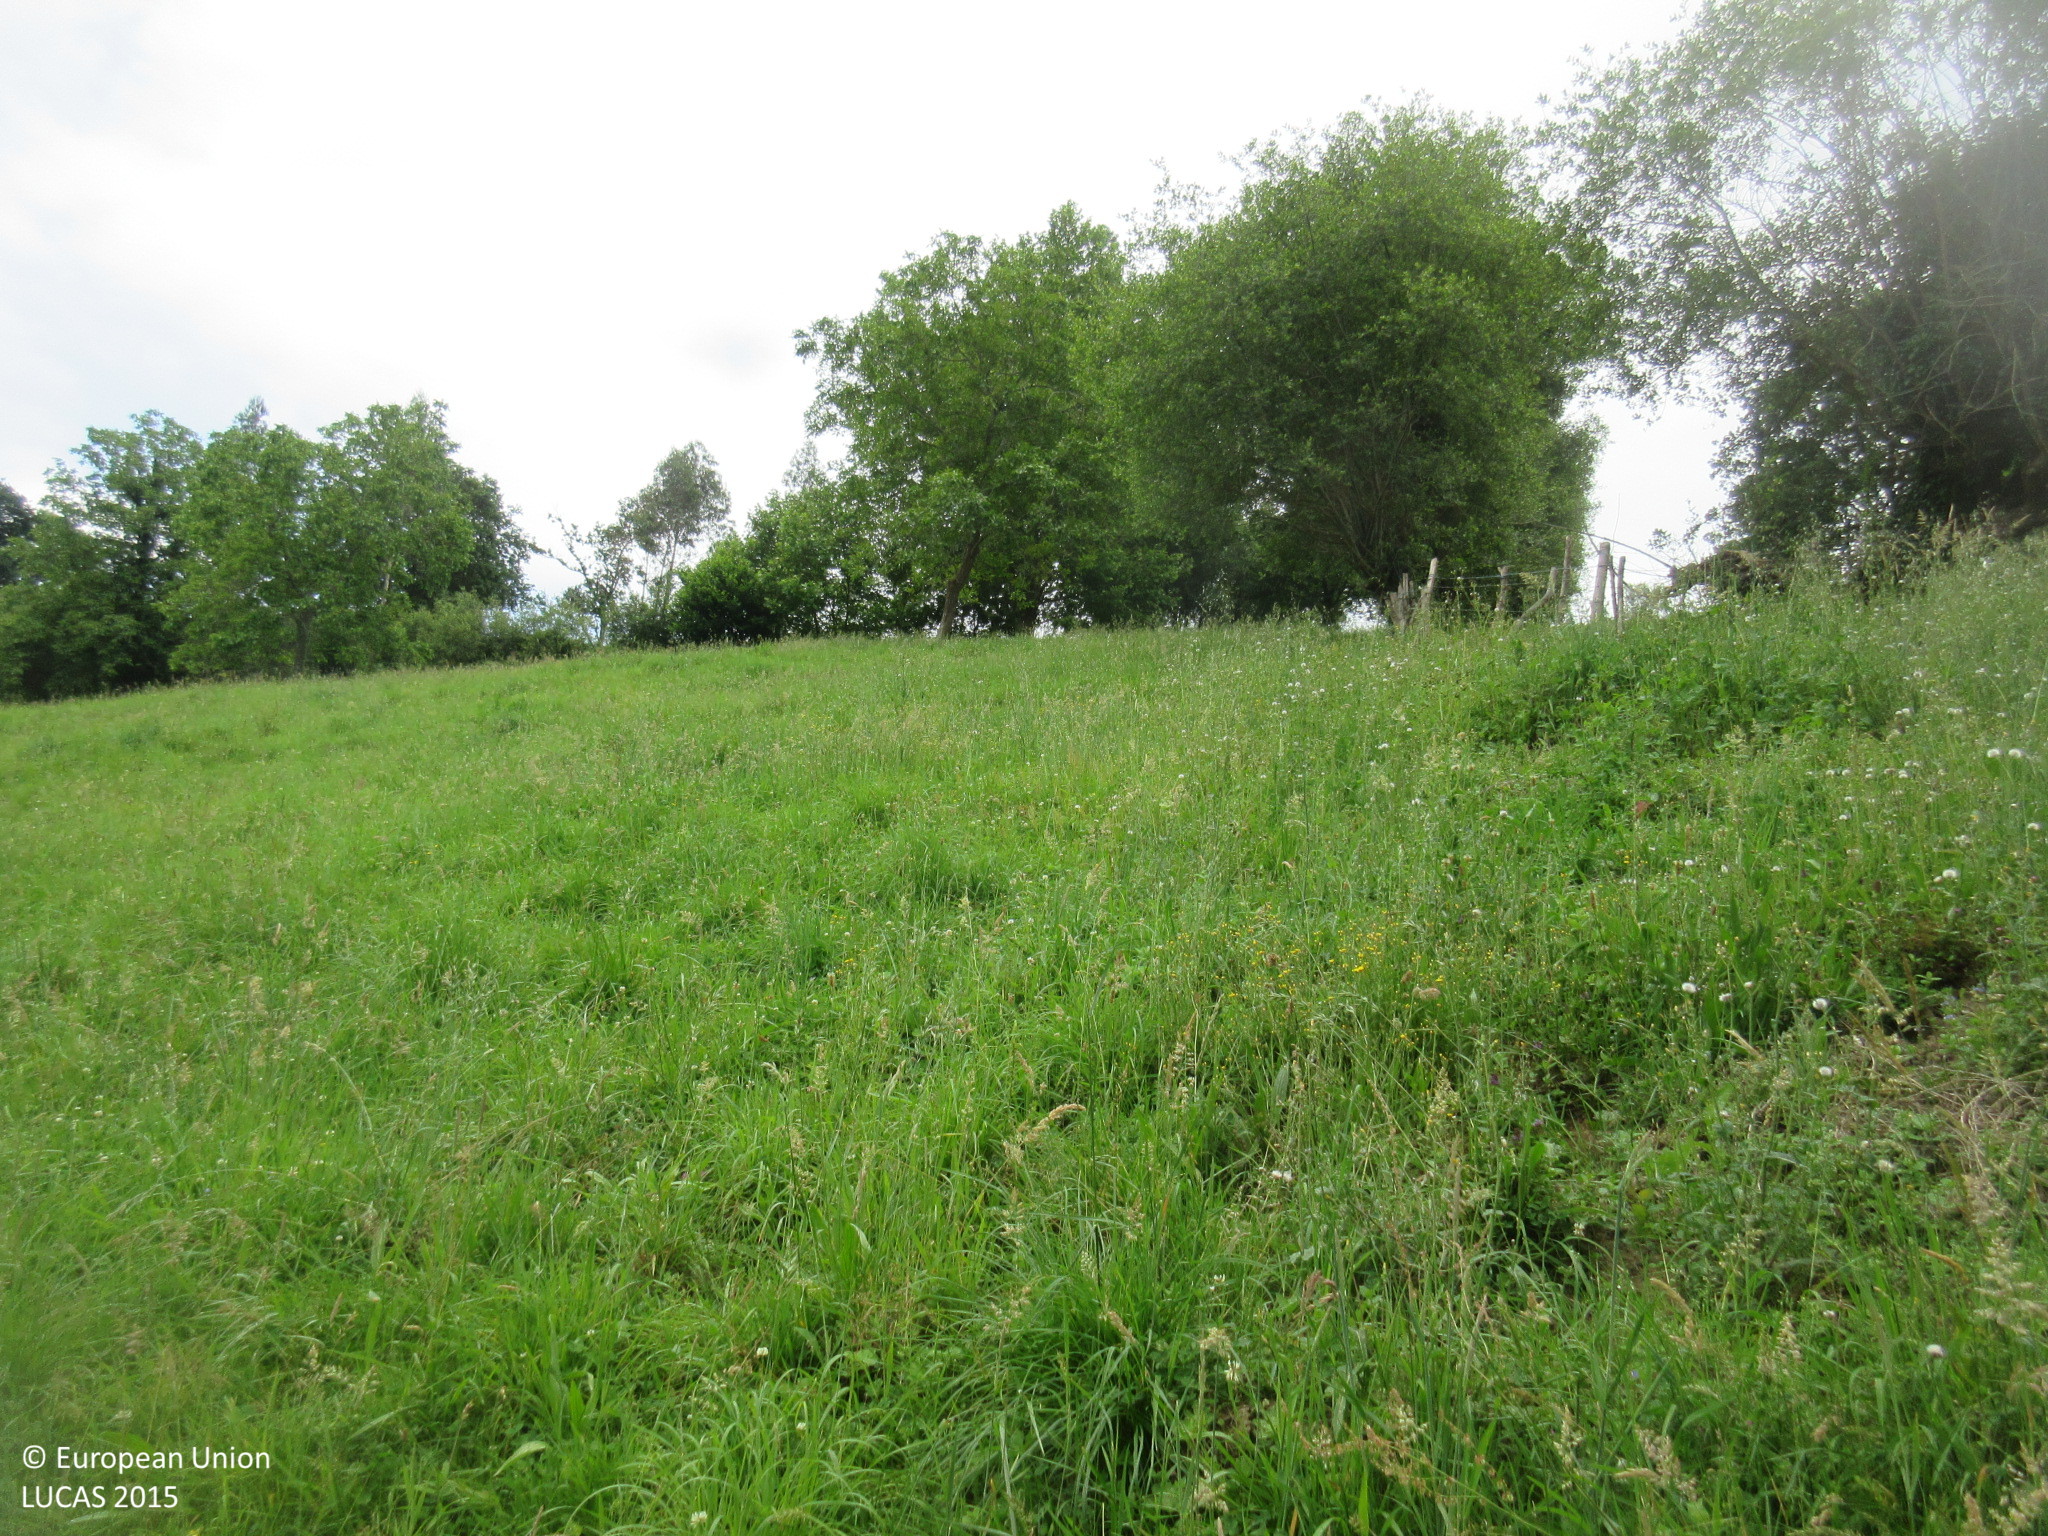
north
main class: Grassland
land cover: Grassland without tree/shrub cover
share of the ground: > 75 %
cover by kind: herbaceous plants 100 %
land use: Agriculture (excluding fallow land and kitchen gardens)
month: June
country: ES
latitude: 43.3583
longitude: -3.6052
